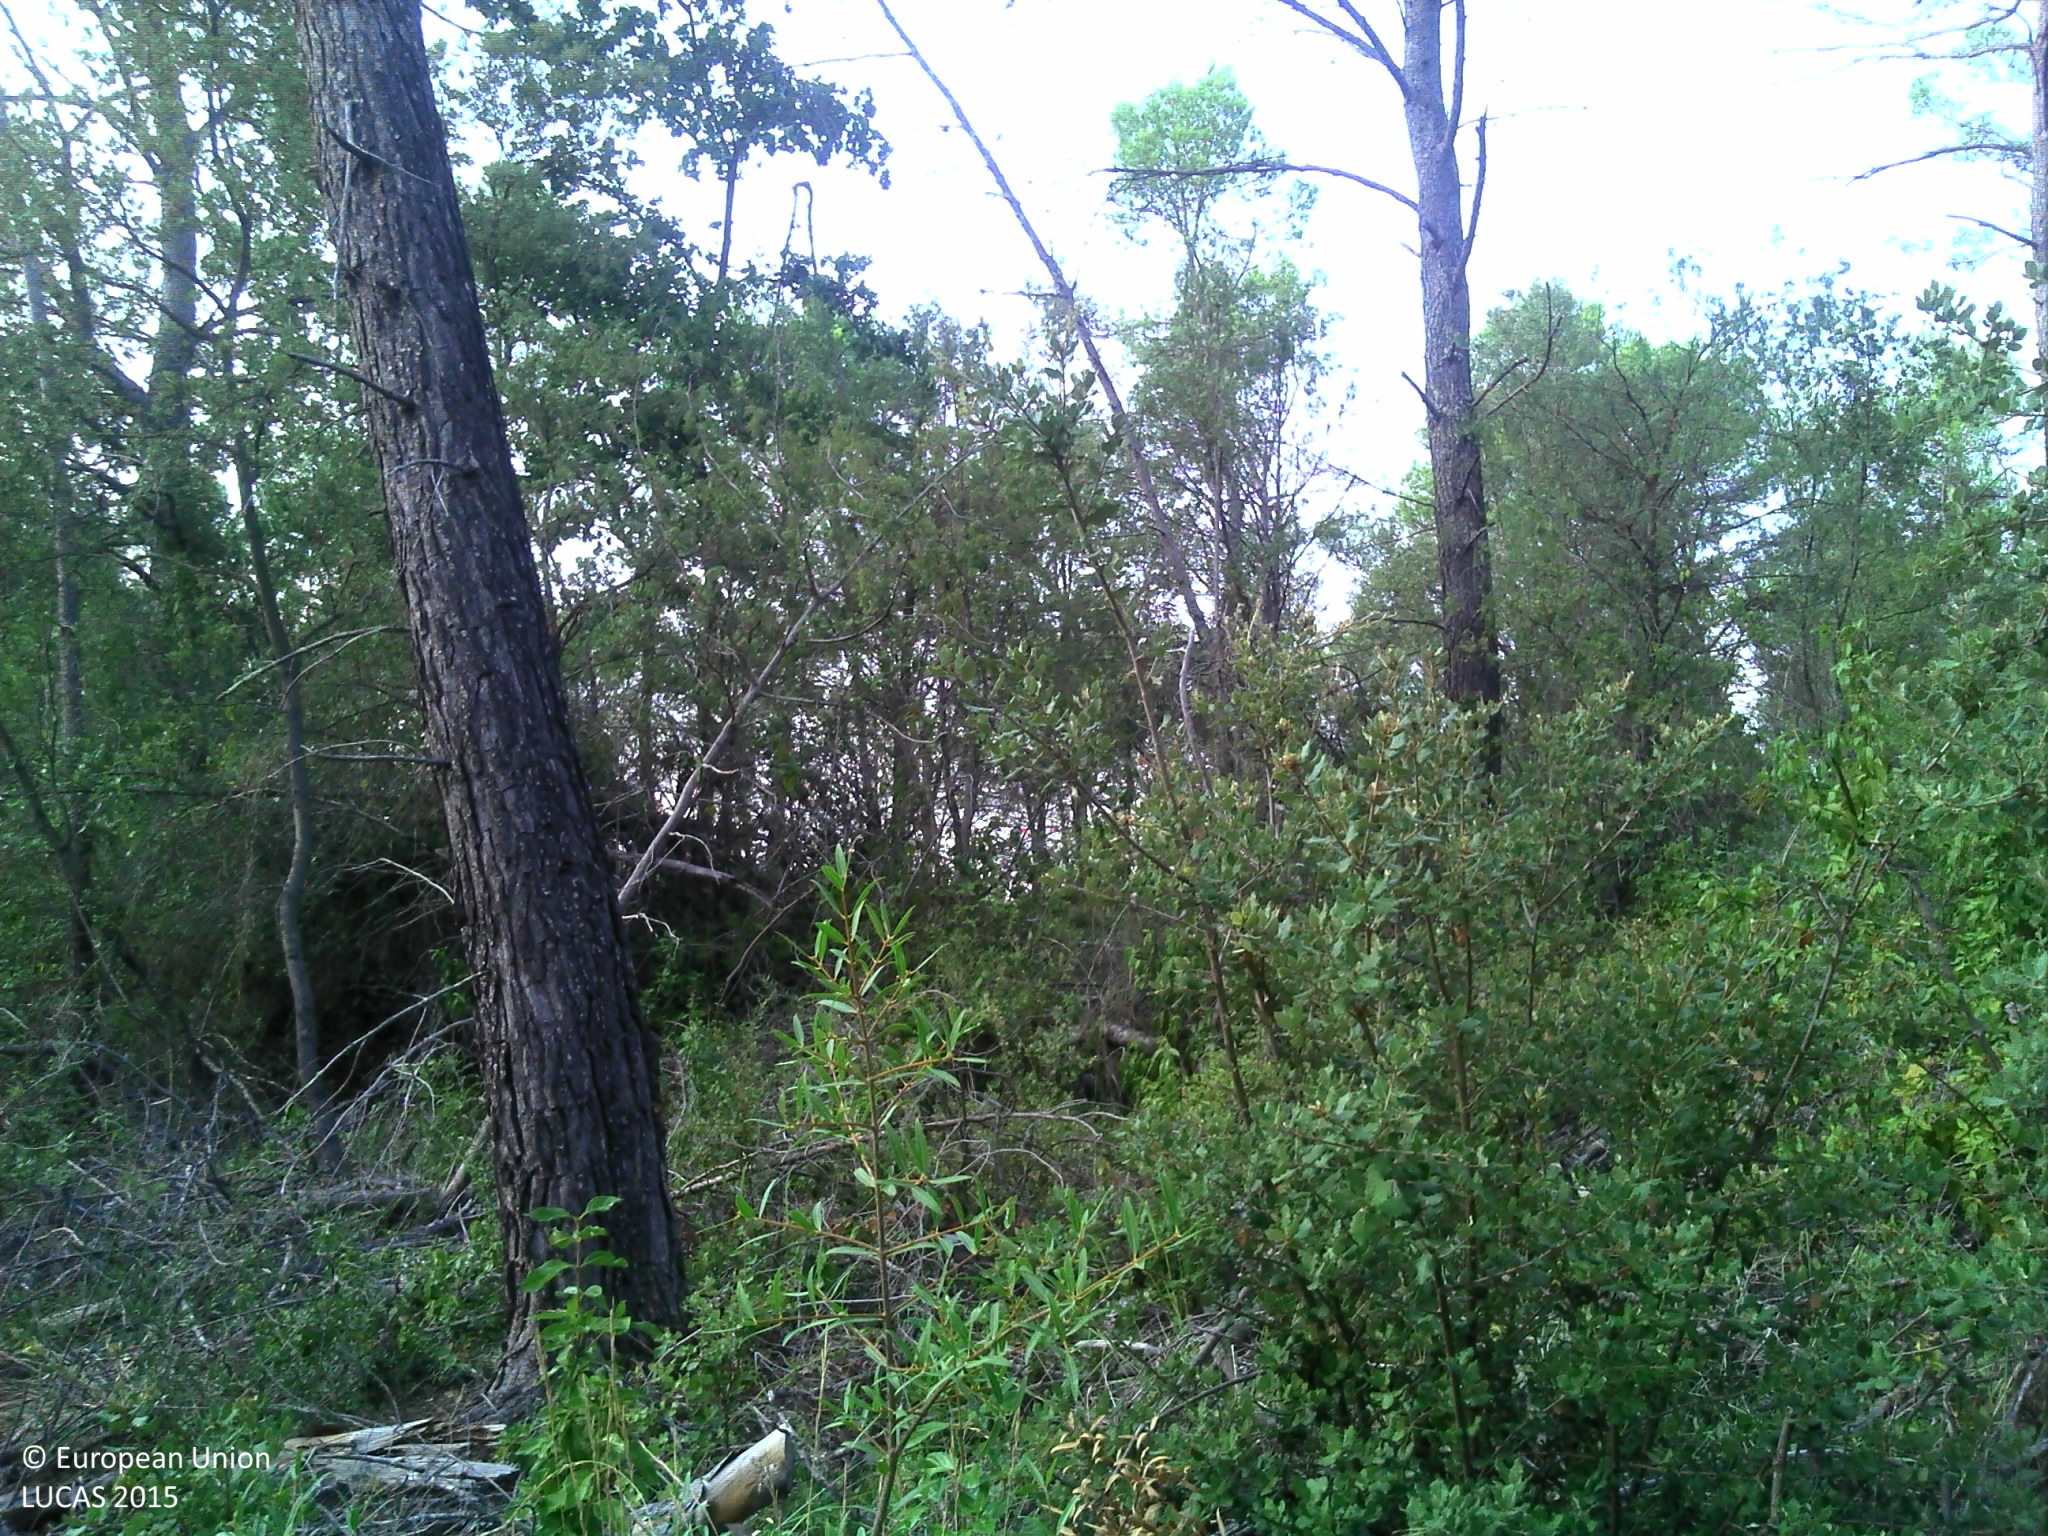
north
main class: Woodland
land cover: Pine dominated mixed woodland
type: coniferous forest of the mediterranean region
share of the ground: > 75 %
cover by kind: coniferous forest trees 50 %, broadleaved forest trees 25 %, shrubs 25 %
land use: Forestry
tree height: > 5 m
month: August
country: FR
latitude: 43.5256
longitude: 6.2846
